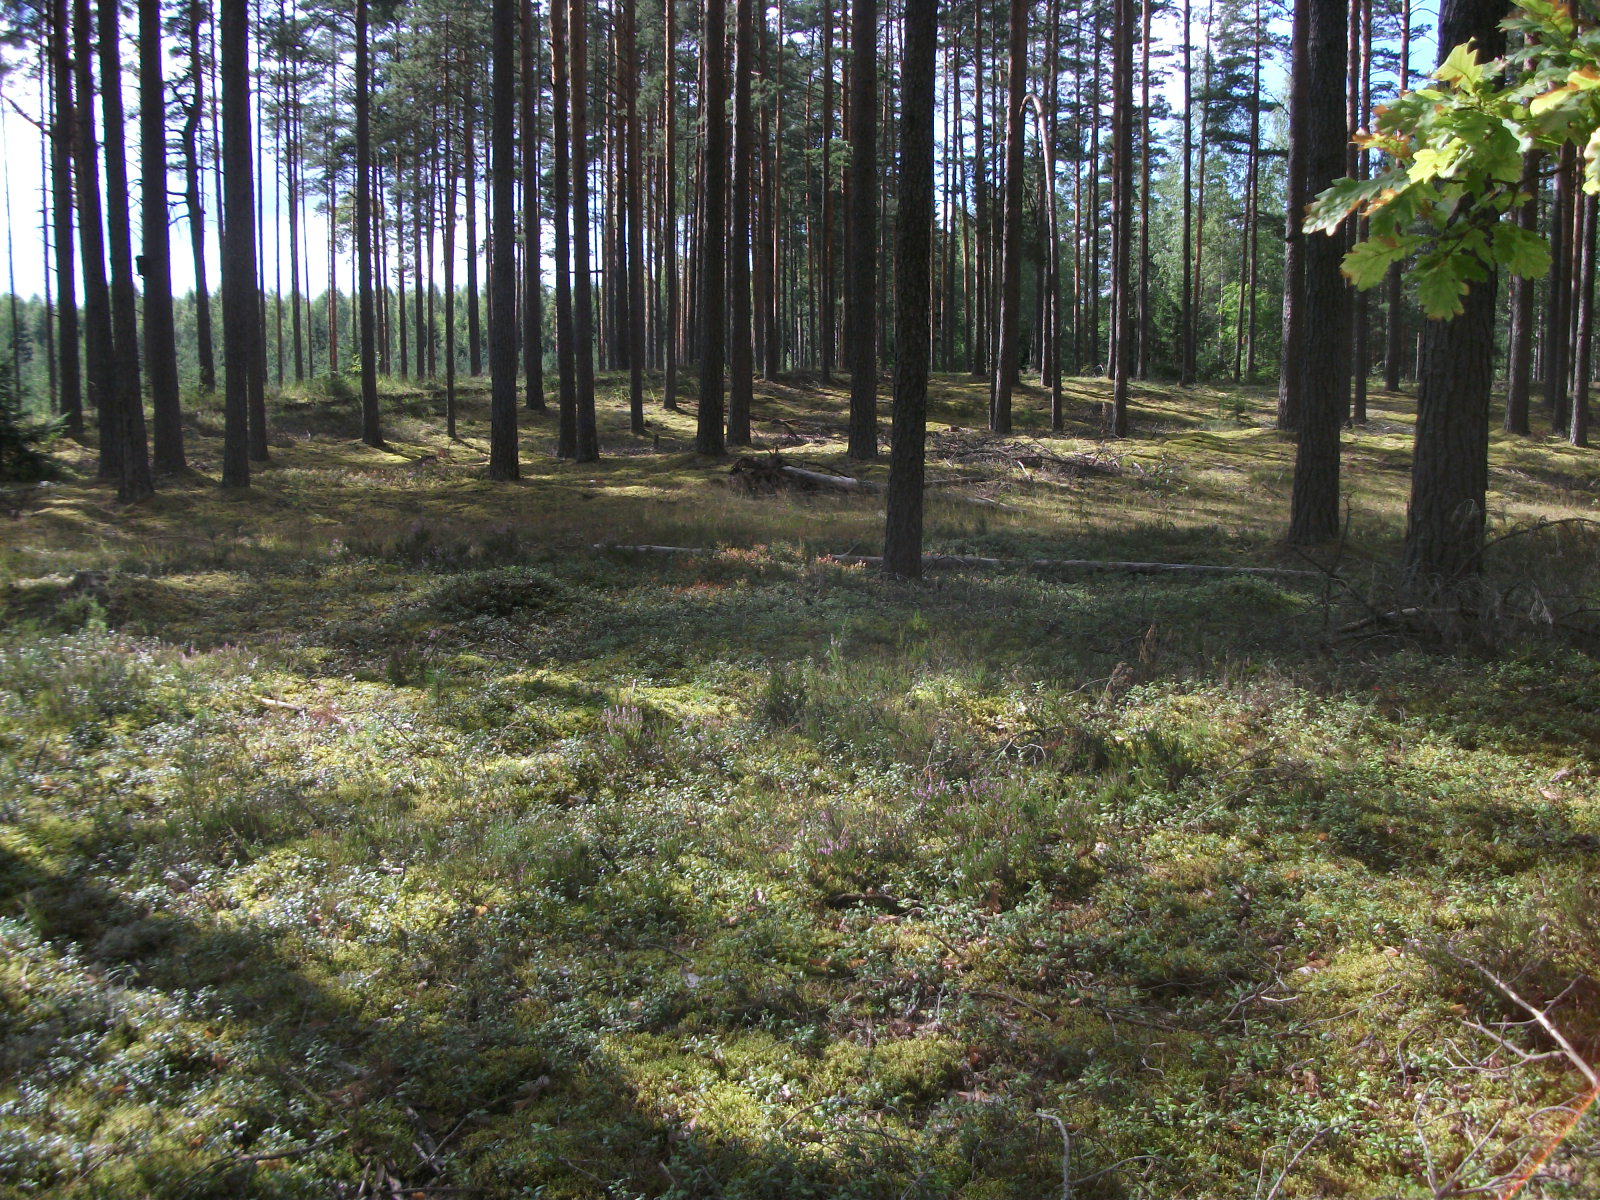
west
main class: Woodland
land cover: Pine dominated coniferous woodland
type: hemiboreal forest and nemoral coniferous forest and mixed broadleaved-coniferous forest
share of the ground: > 75 %
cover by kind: coniferous forest trees 80 %, lichens and mosses 20 %
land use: Forestry
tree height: > 5 m
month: August
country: LV
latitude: 56.4658
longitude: 26.3918
